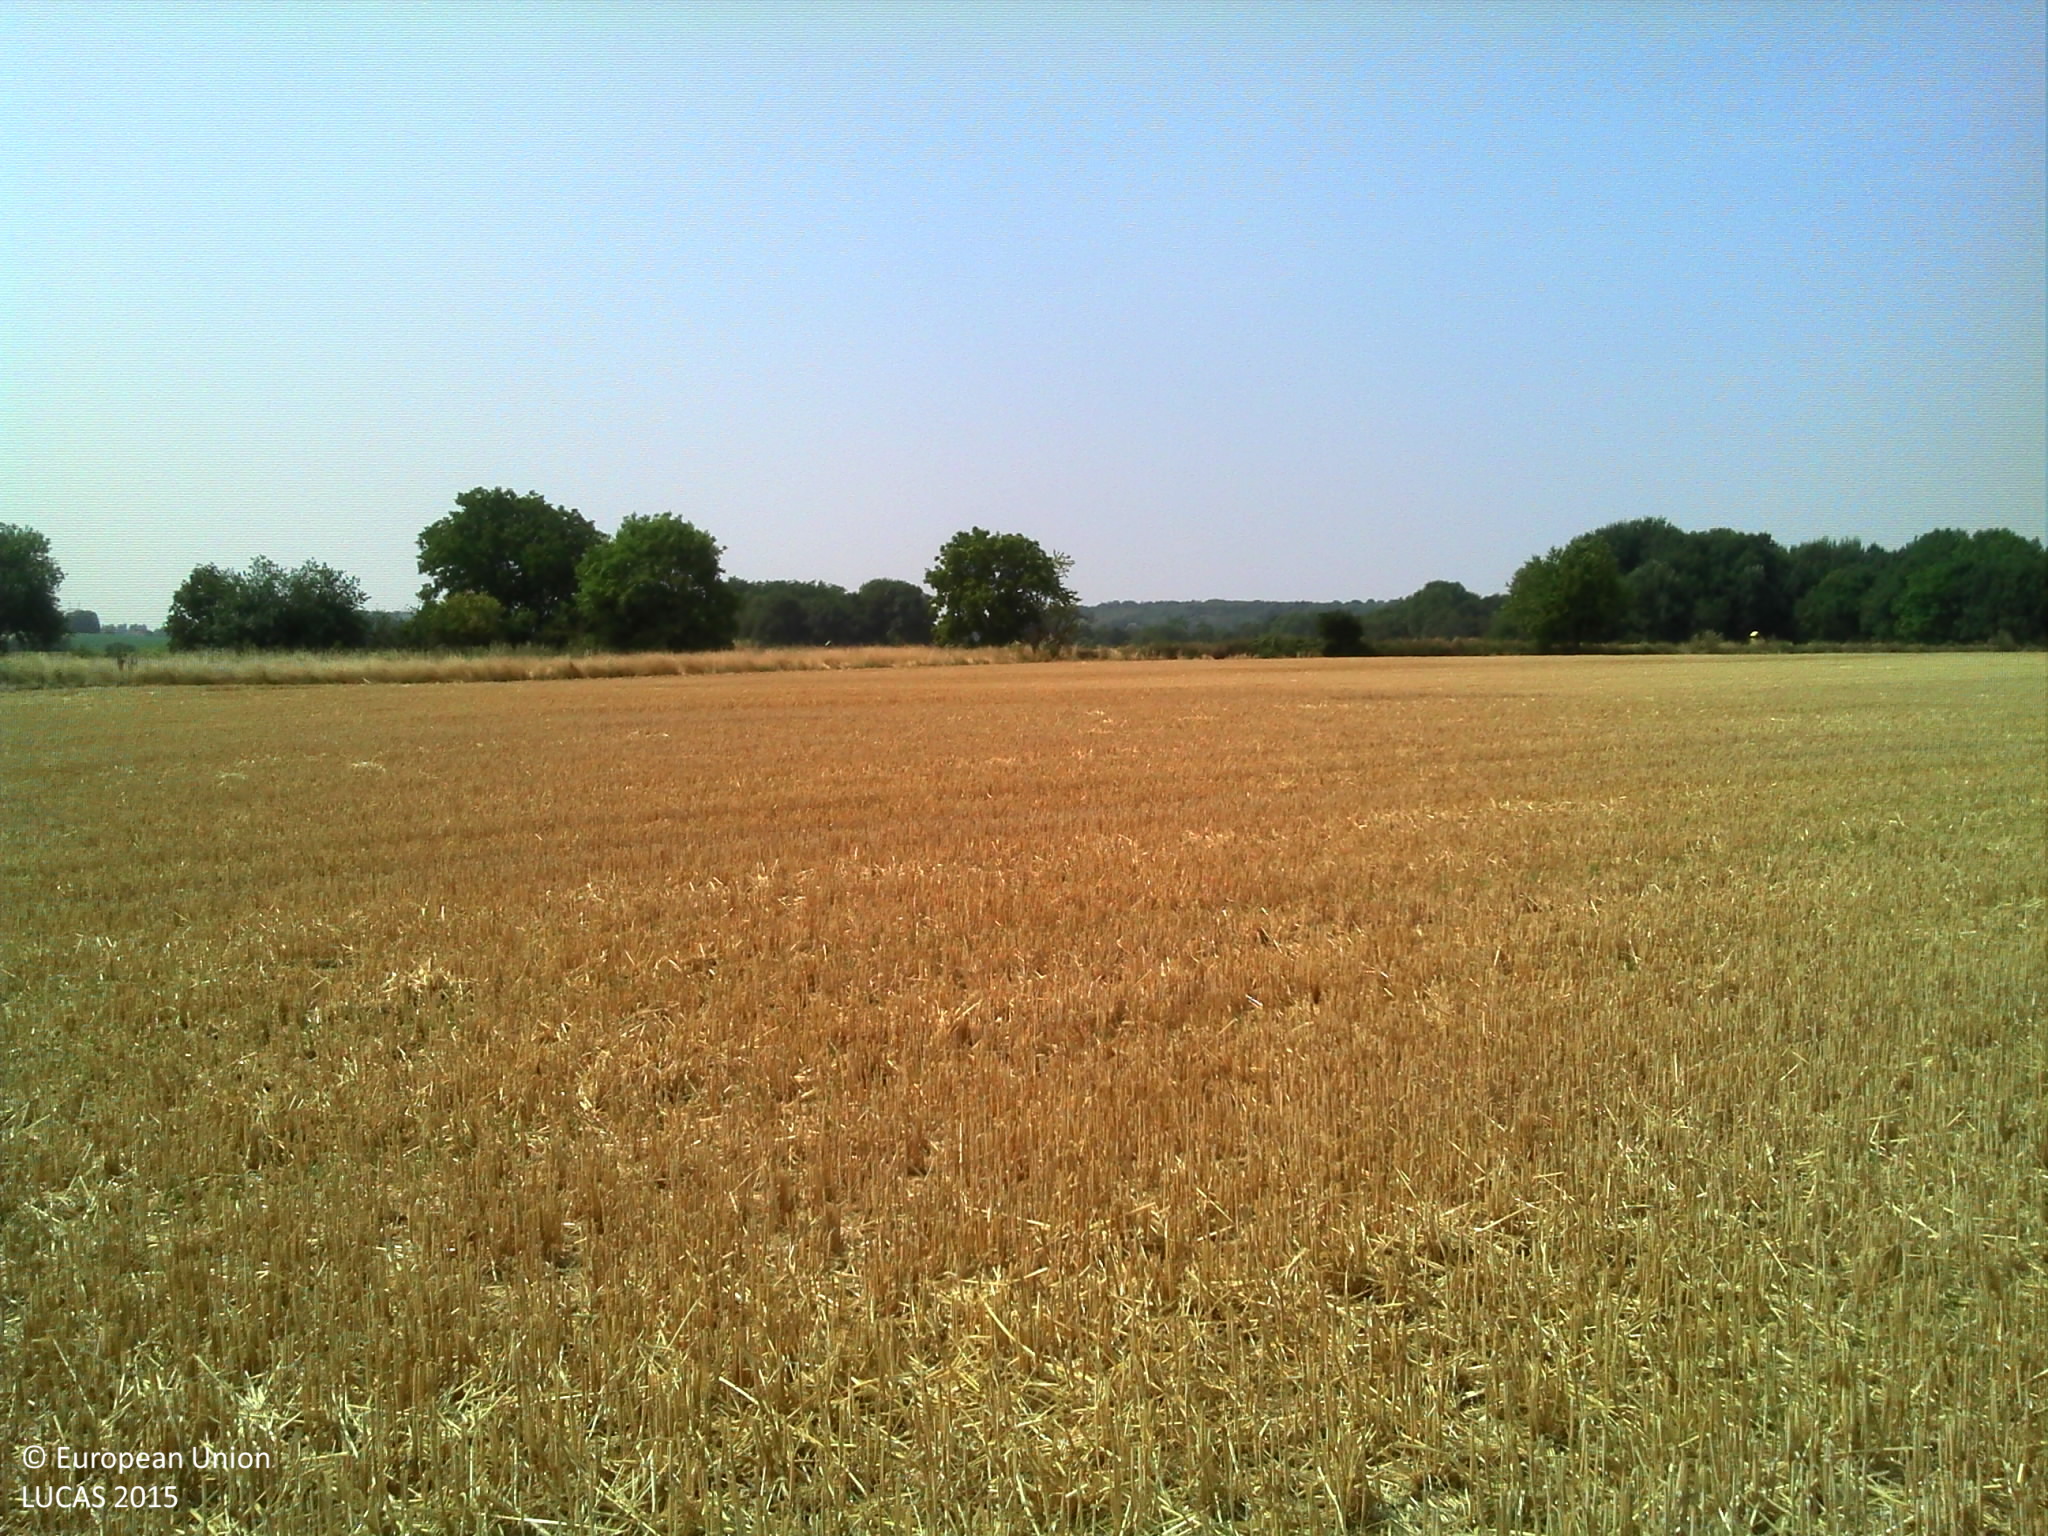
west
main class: Cropland
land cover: Triticale
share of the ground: > 75 %
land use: Agriculture (excluding fallow land and kitchen gardens)
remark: Harvested field
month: August
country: FR
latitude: 49.0056
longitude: 2.8957
